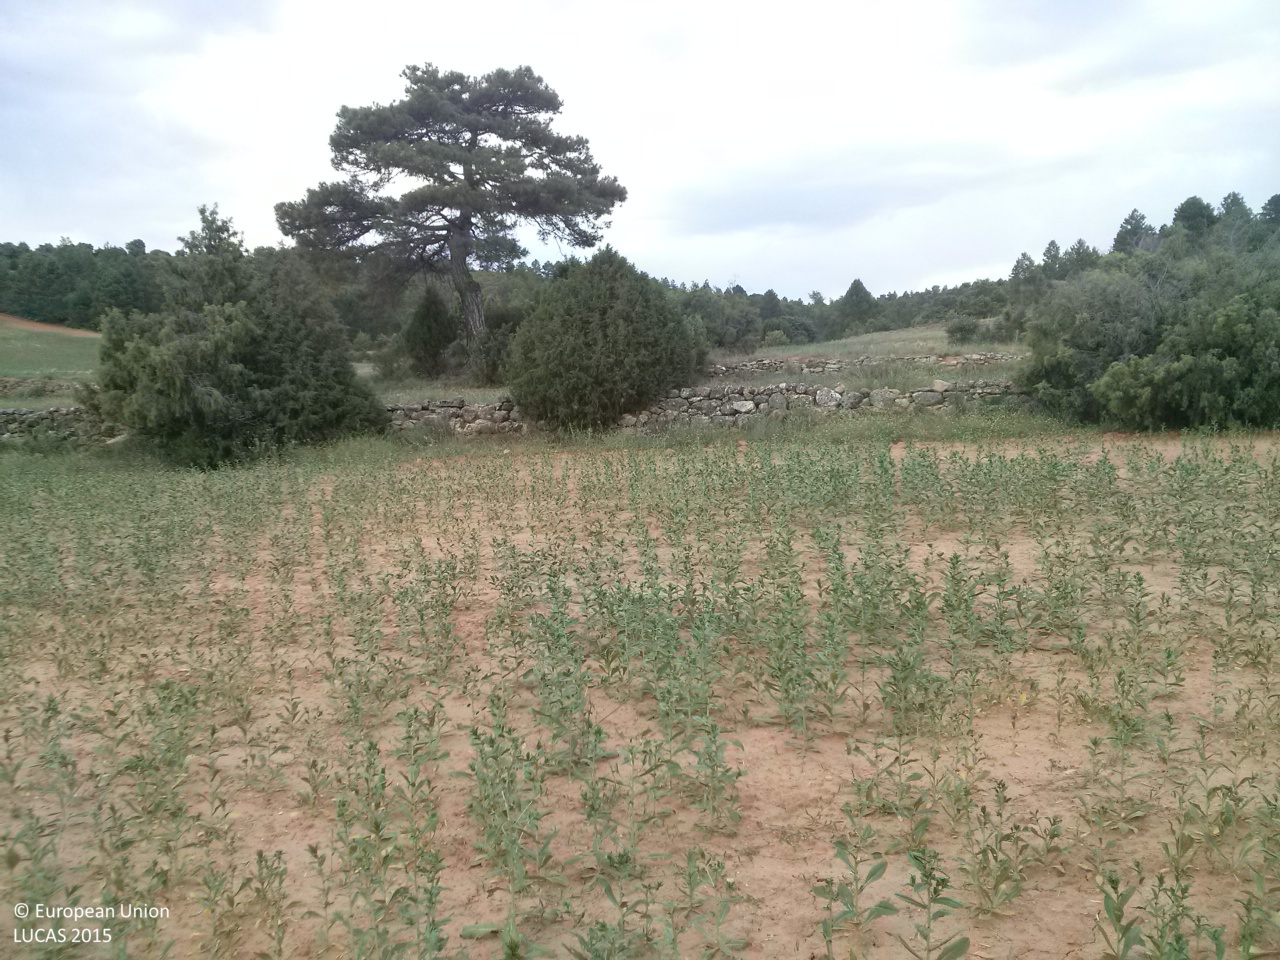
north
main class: Cropland
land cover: Other fibre and oleaginous crops
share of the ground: > 75 %
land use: Agriculture (excluding fallow land and kitchen gardens)
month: June
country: ES
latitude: 39.9629
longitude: -1.7297
